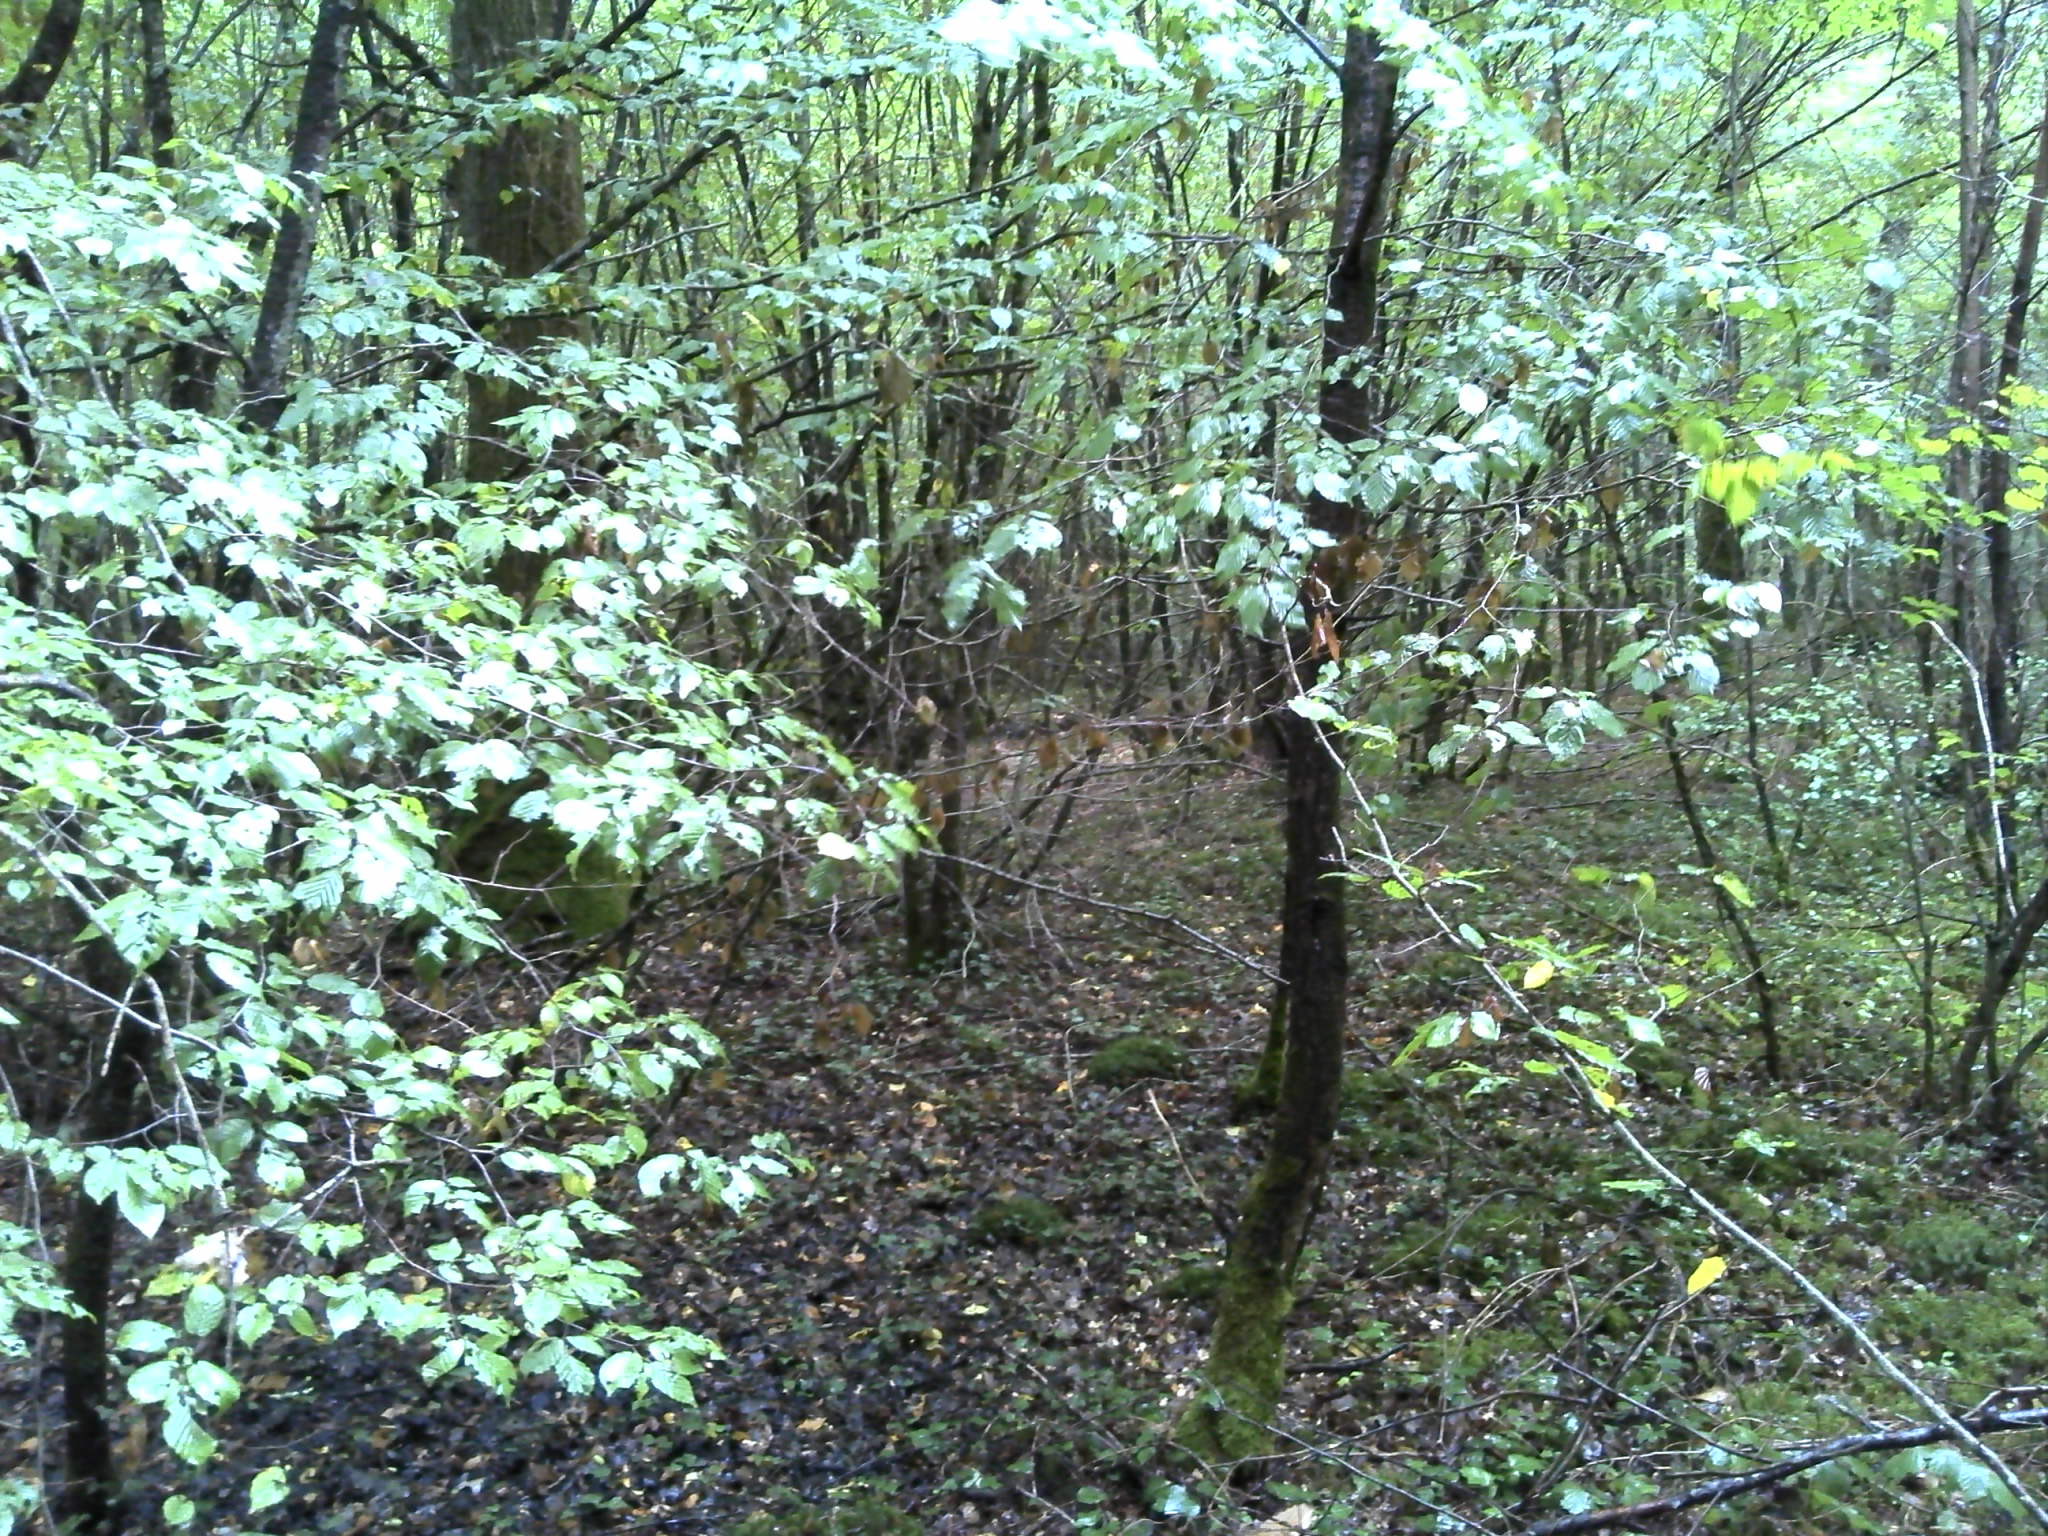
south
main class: Woodland
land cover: Broadleaved woodland
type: mesophytic deciduous forest
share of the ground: > 75 %
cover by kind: broadleaved forest trees 95 %, herbaceous plants 5 %
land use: Forestry
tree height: > 5 m
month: August
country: FR
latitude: 46.7225
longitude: 1.5502
